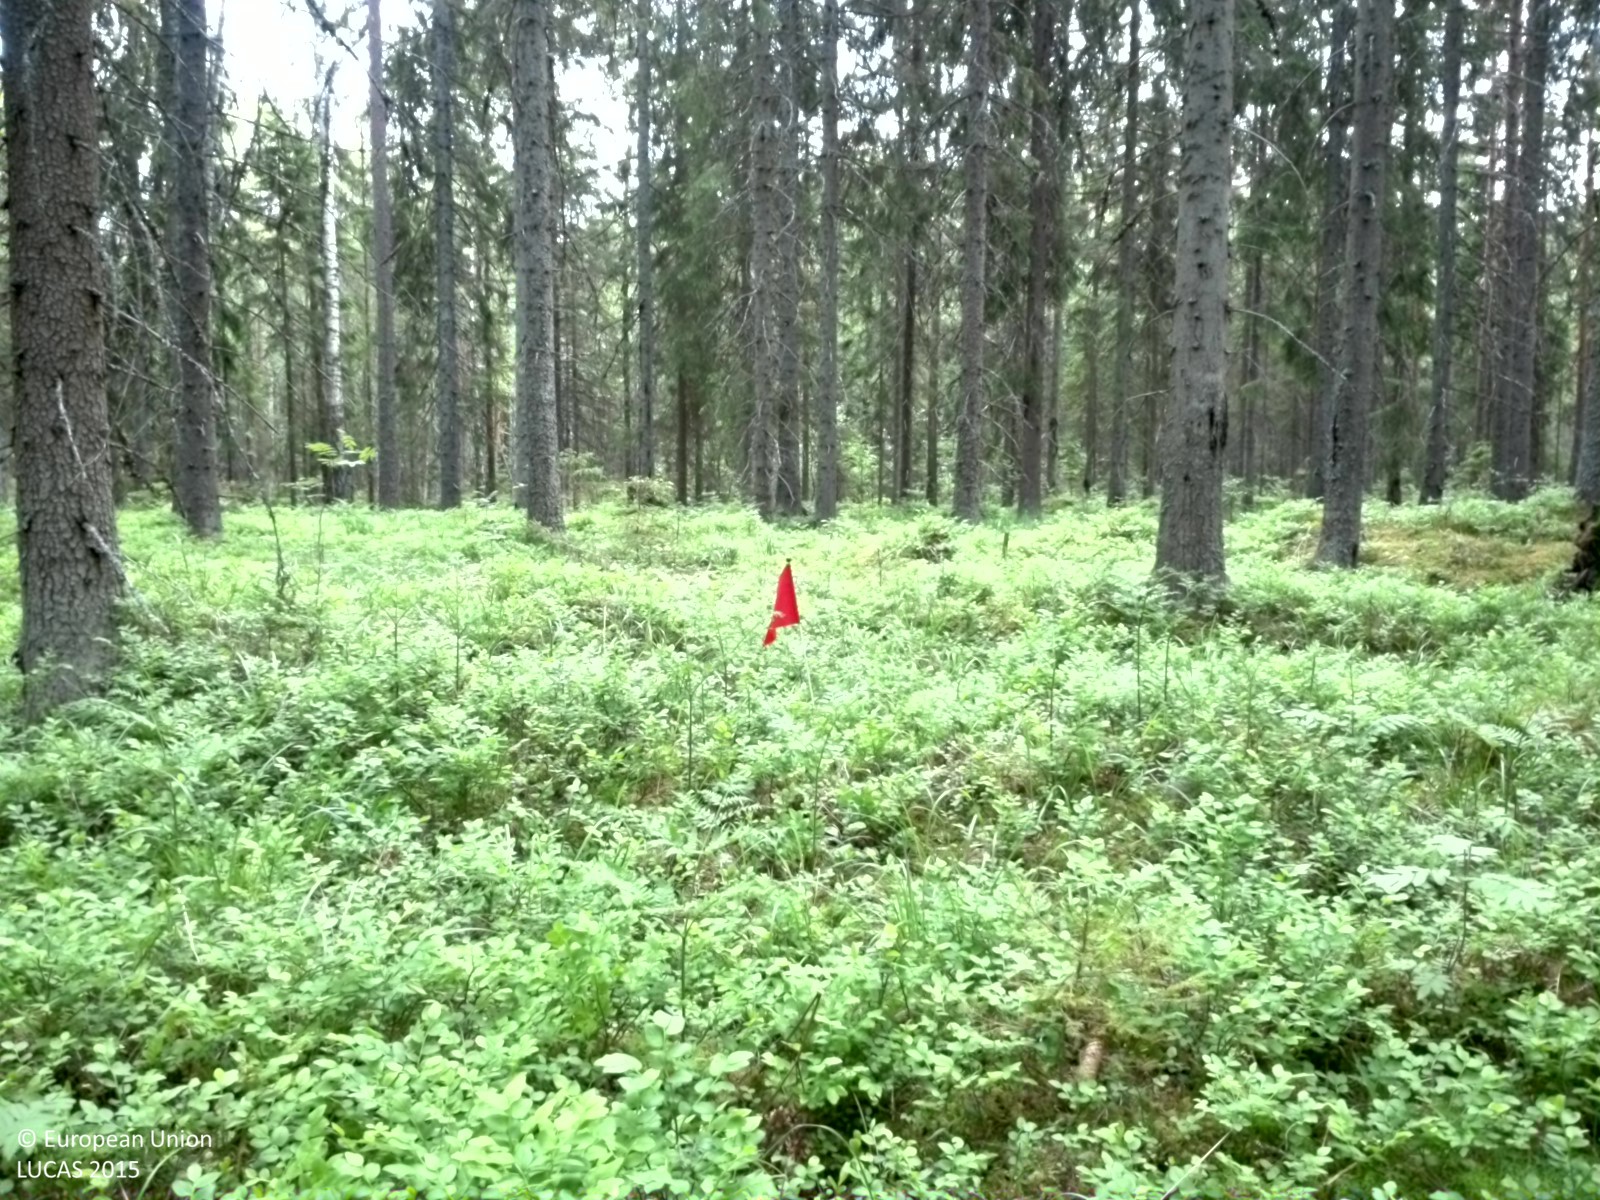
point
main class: Woodland
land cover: Spruce dominated coniferous woodland
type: boreal forest
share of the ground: > 75 %
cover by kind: coniferous forest trees 70 %, shrubs 20 %, broadleaved forest trees 5 %, herbaceous plants 5 %
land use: Forestry
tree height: > 5 m
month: June
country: SE
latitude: 60.3449
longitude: 17.1112
